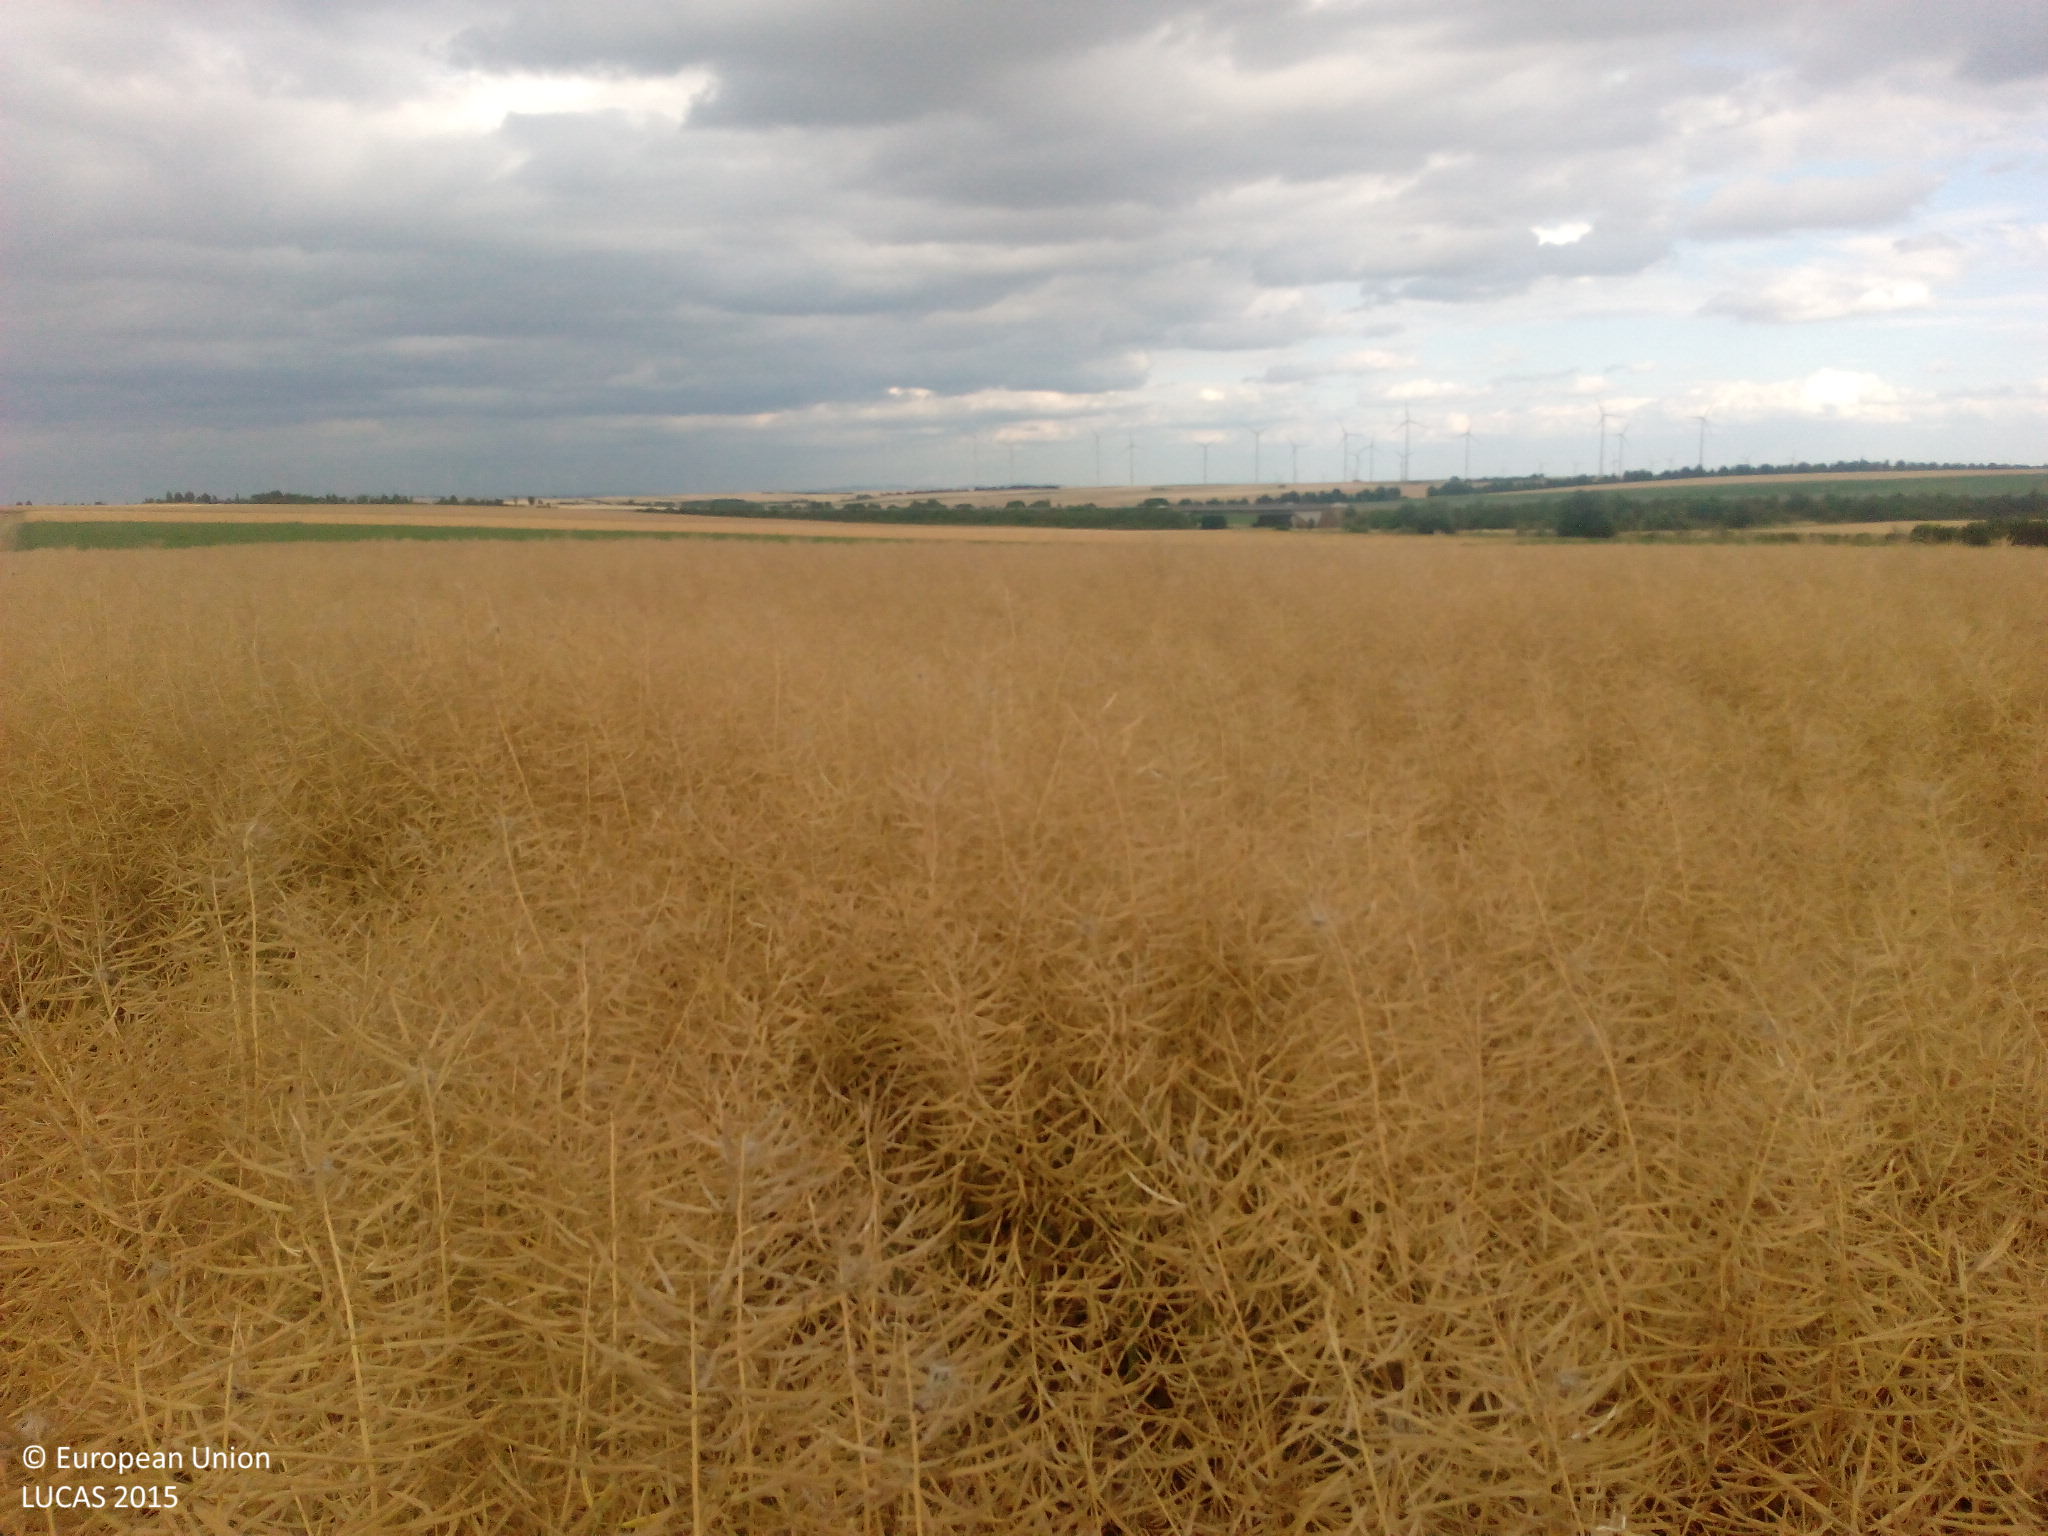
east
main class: Cropland
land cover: Rape and turnip rape
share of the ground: > 75 %
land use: Agriculture (excluding fallow land and kitchen gardens)
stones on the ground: < 10 %
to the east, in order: Rape and turnip rape; Sugar beet
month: July
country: DE
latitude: 49.6998
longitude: 8.0455
